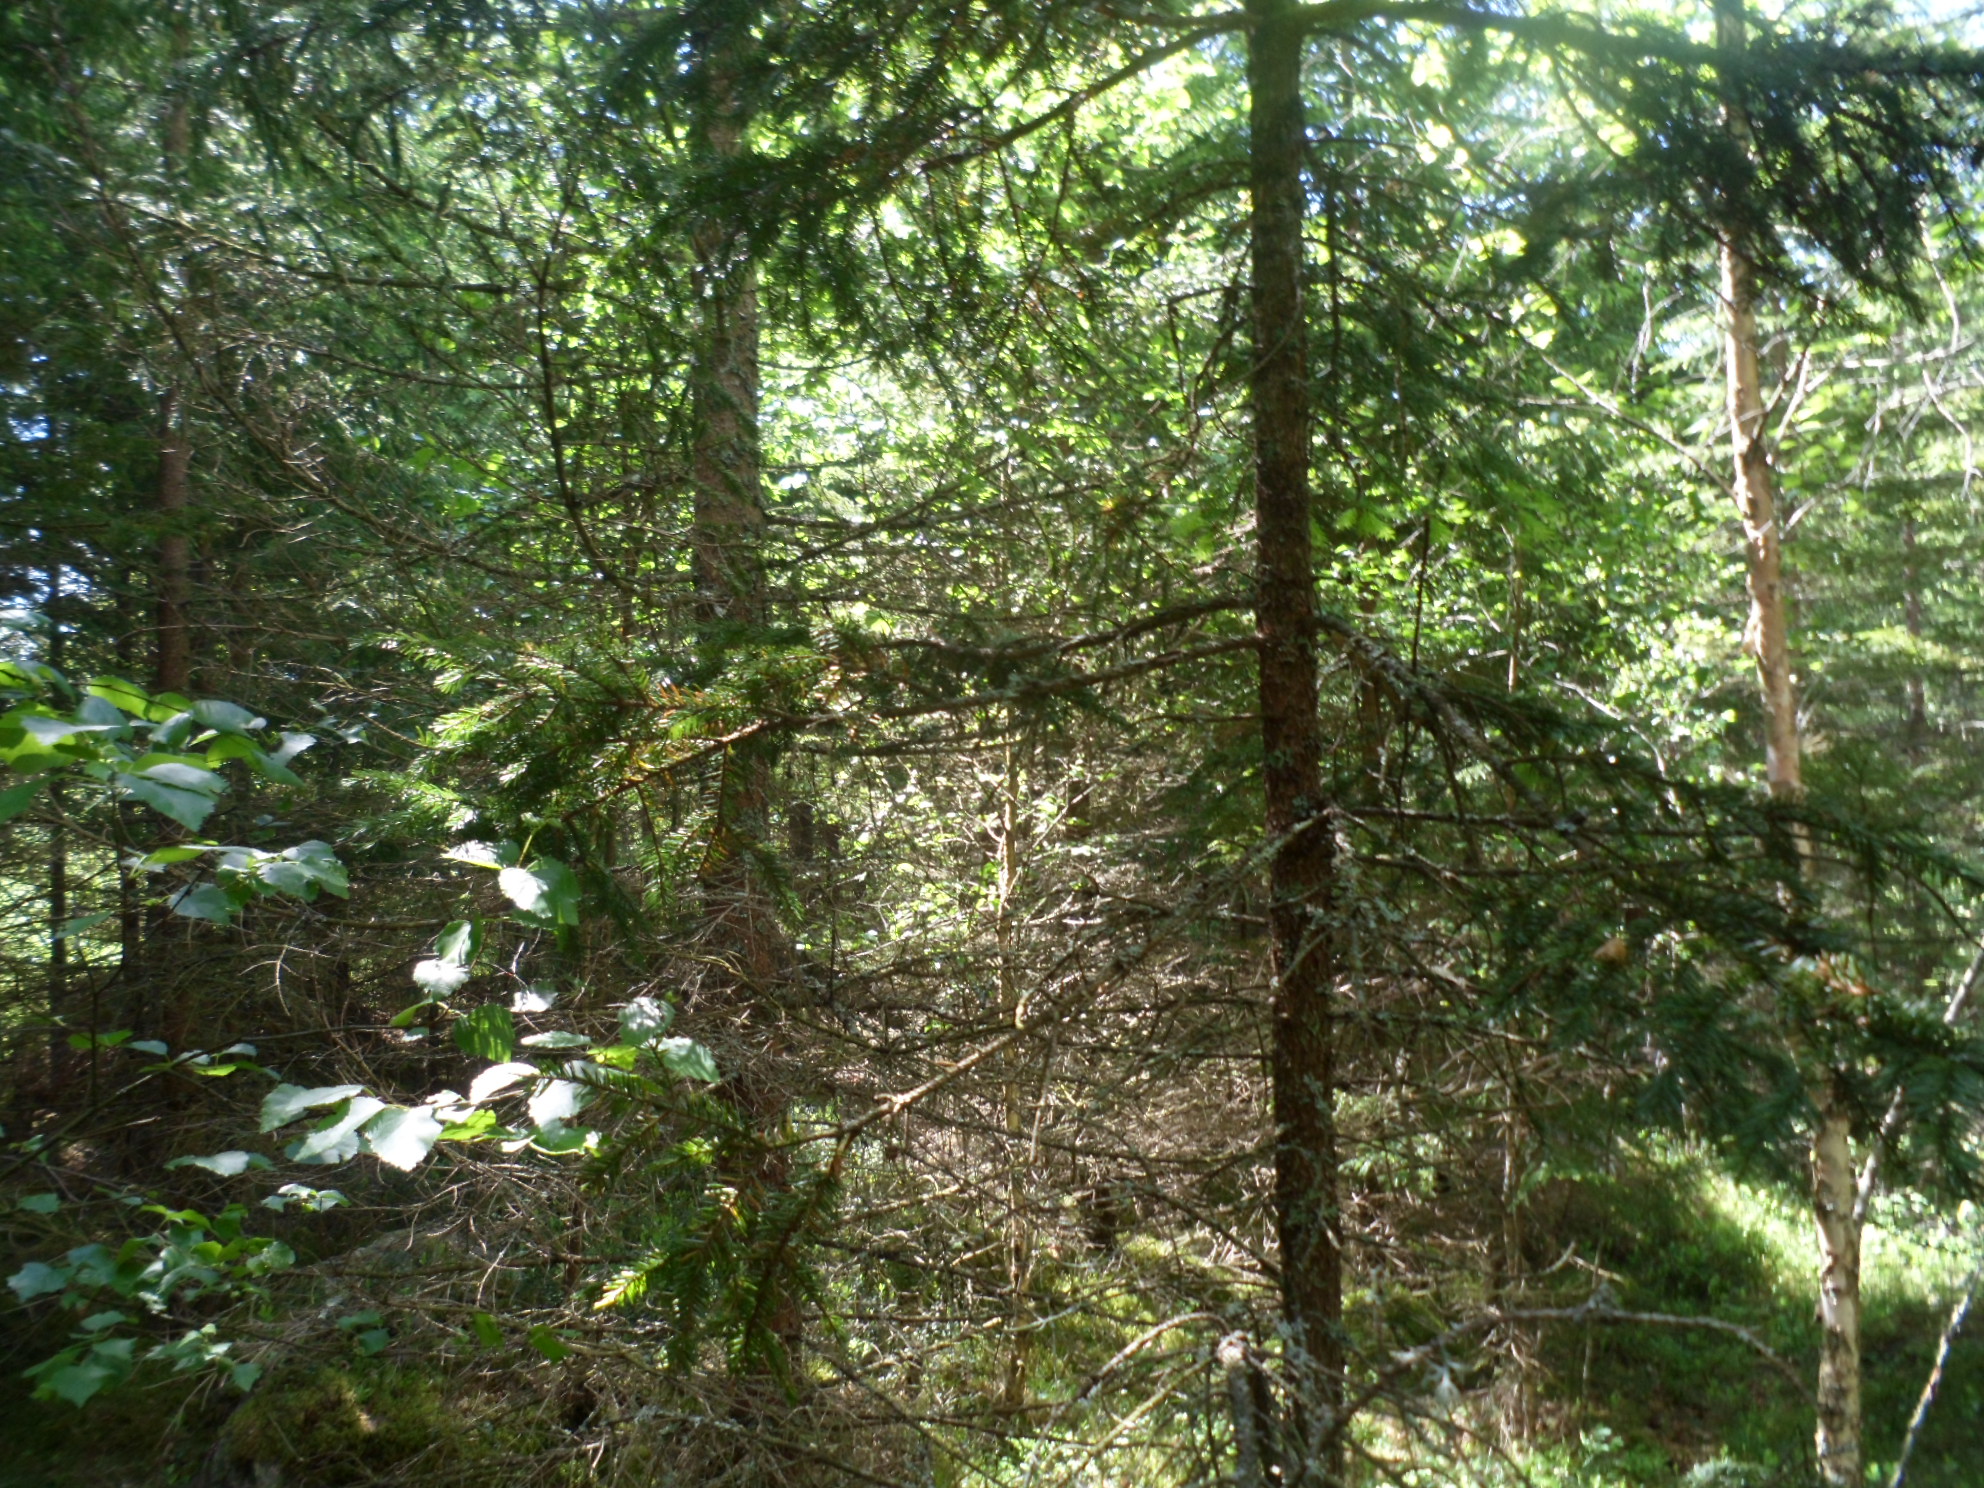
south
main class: Woodland
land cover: Spruce dominated coniferous woodland
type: boreal forest
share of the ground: > 75 %
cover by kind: coniferous forest trees 75 %, lichens and mosses 10 %, broadleaved forest trees 5 %, shrubs 5 %, herbaceous plants 5 %
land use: Forestry
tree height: > 5 m
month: July
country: SE
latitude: 57.4043
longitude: 14.5396
